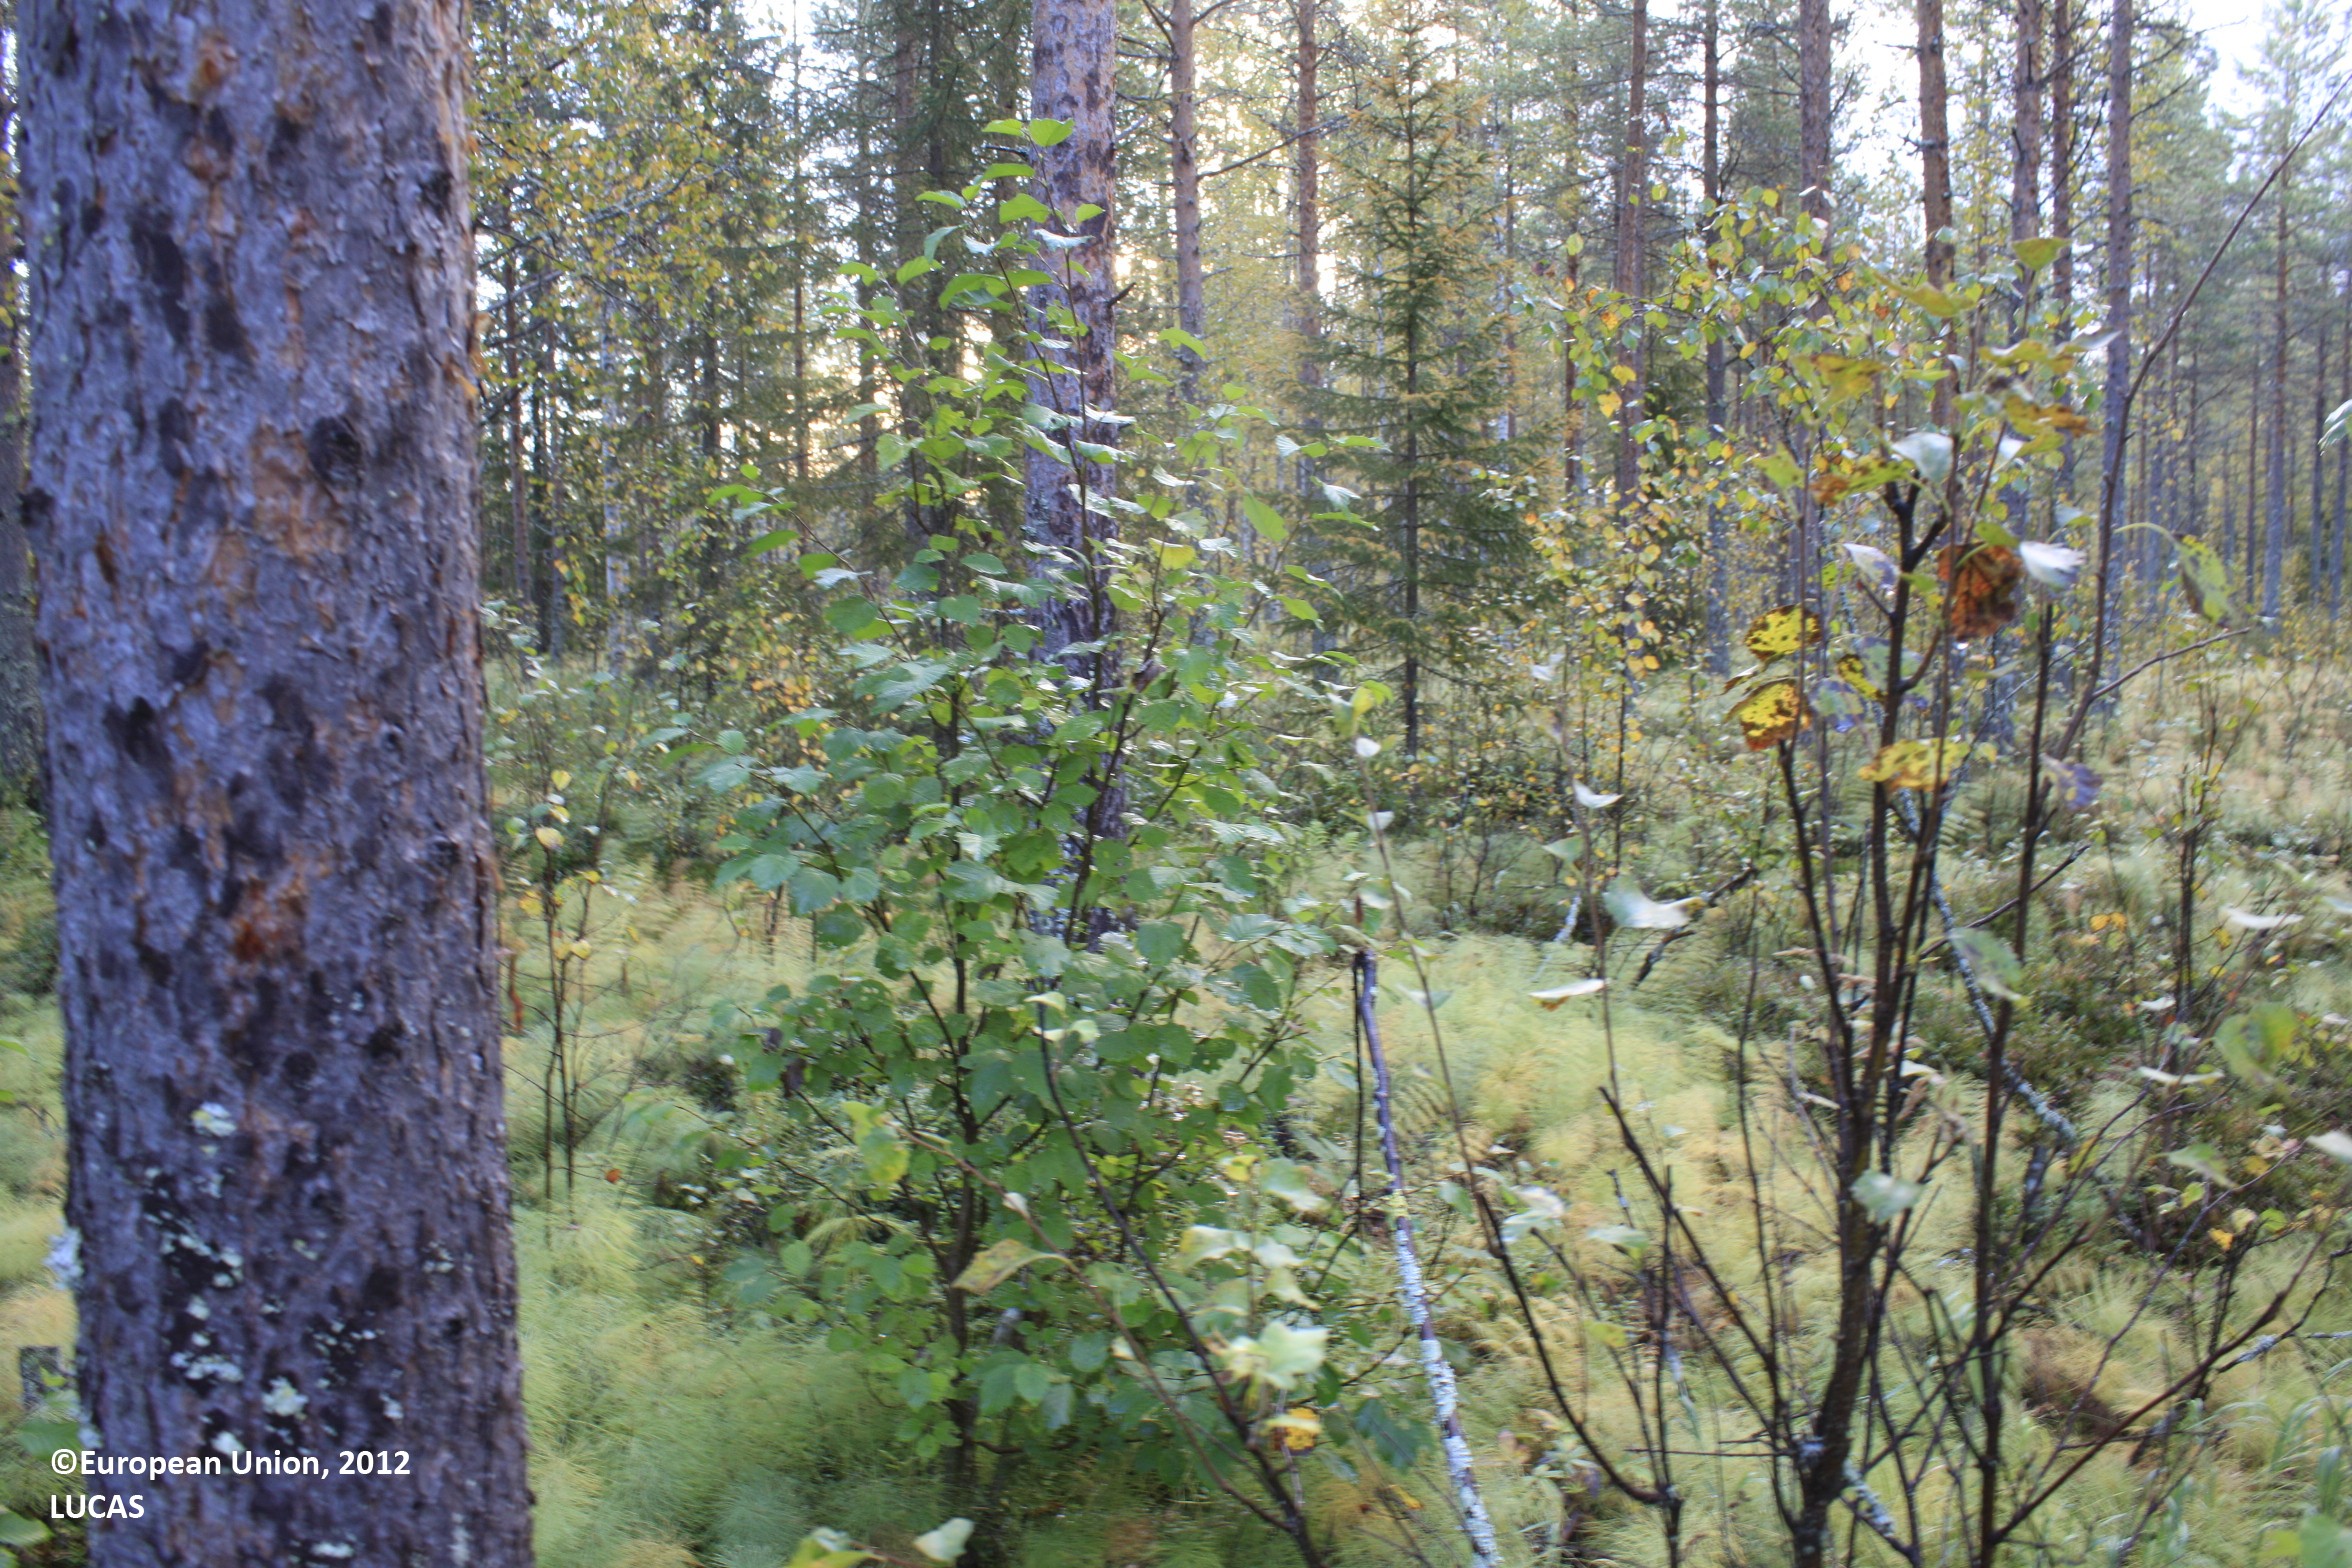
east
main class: Woodland
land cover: Pine dominated mixed woodland
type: boreal forest
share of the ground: 50 - 75 %
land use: Forestry
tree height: > 5 m
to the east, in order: Pine dominated mixed woodland; Ditches and canals; Pine dominated mixed woodland; Ditches and canals; Pine dominated coniferous woodland; Ditches and canals; Pine dominated coniferous woodland; Fences; Other coniferous woodland; Grassland without tree/shrub cover
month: September
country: FI
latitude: 65.4797
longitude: 26.6246
